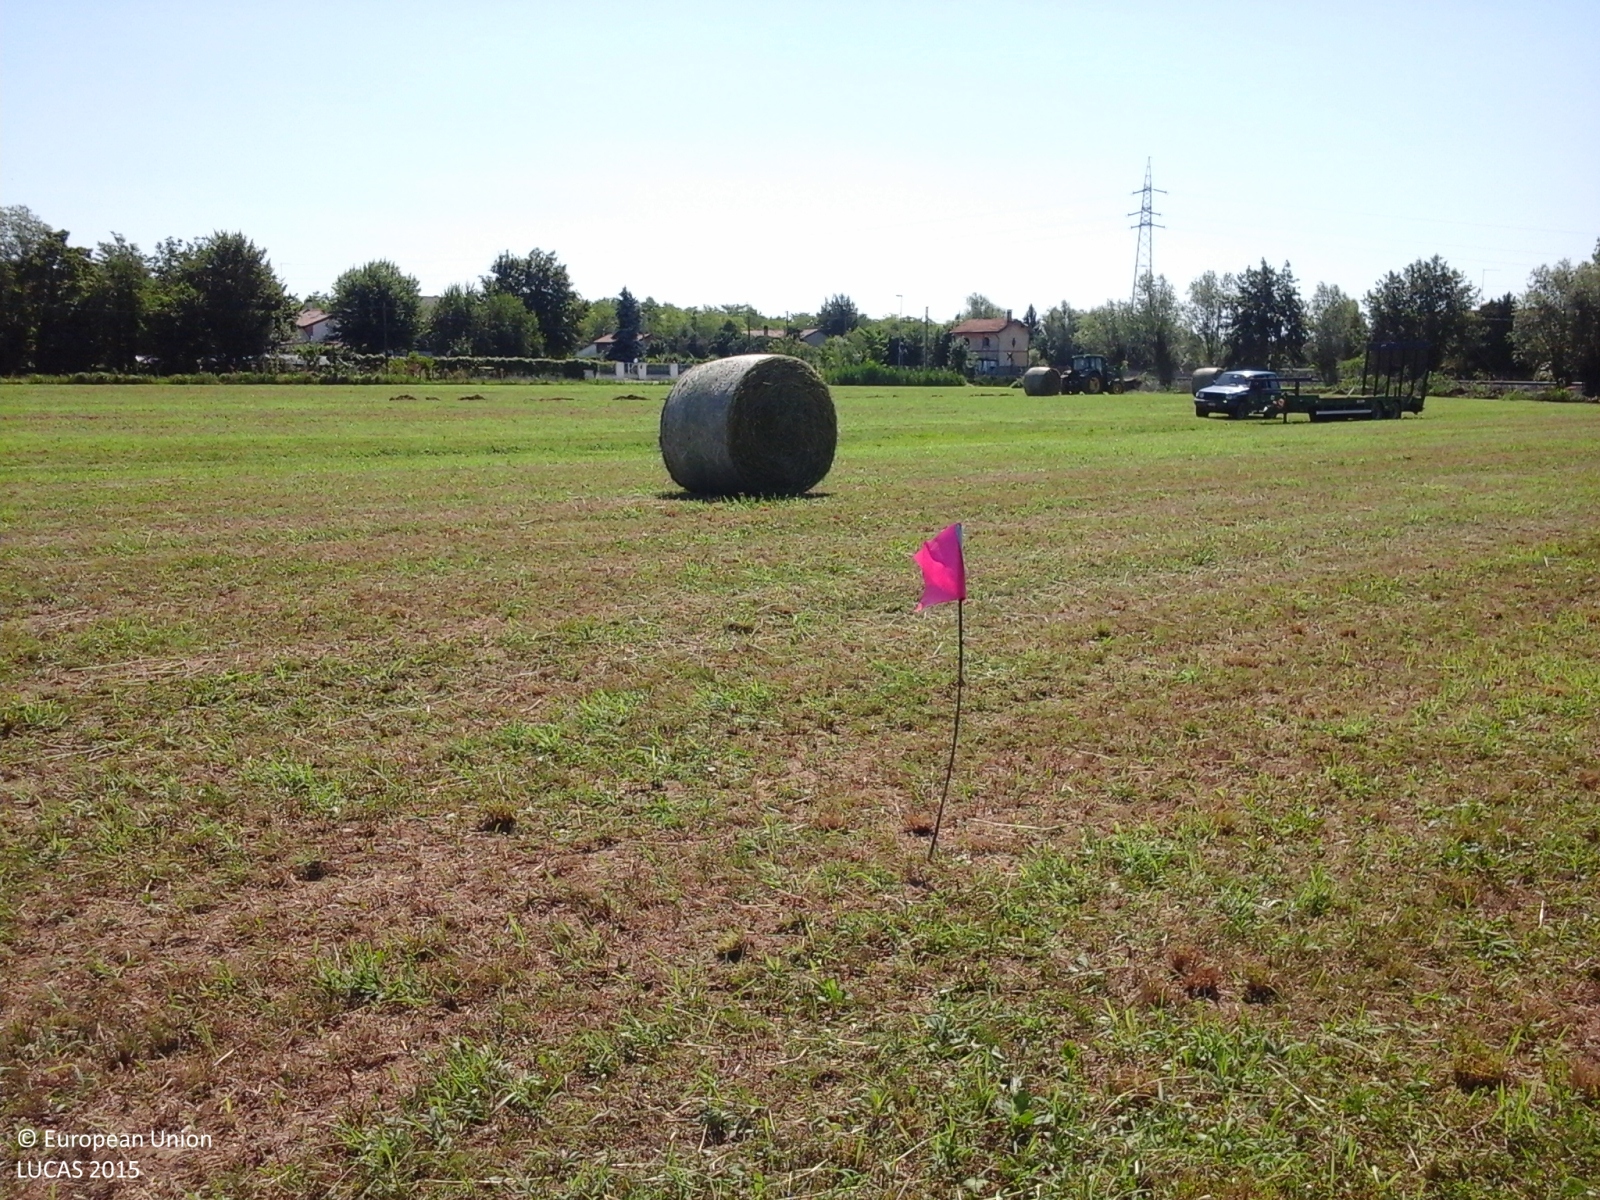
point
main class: Grassland
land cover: Grassland without tree/shrub cover
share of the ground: > 75 %
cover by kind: herbaceous plants 100 %
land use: Agriculture (excluding fallow land and kitchen gardens)
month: July
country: IT
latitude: 45.6772
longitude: 12.3203
